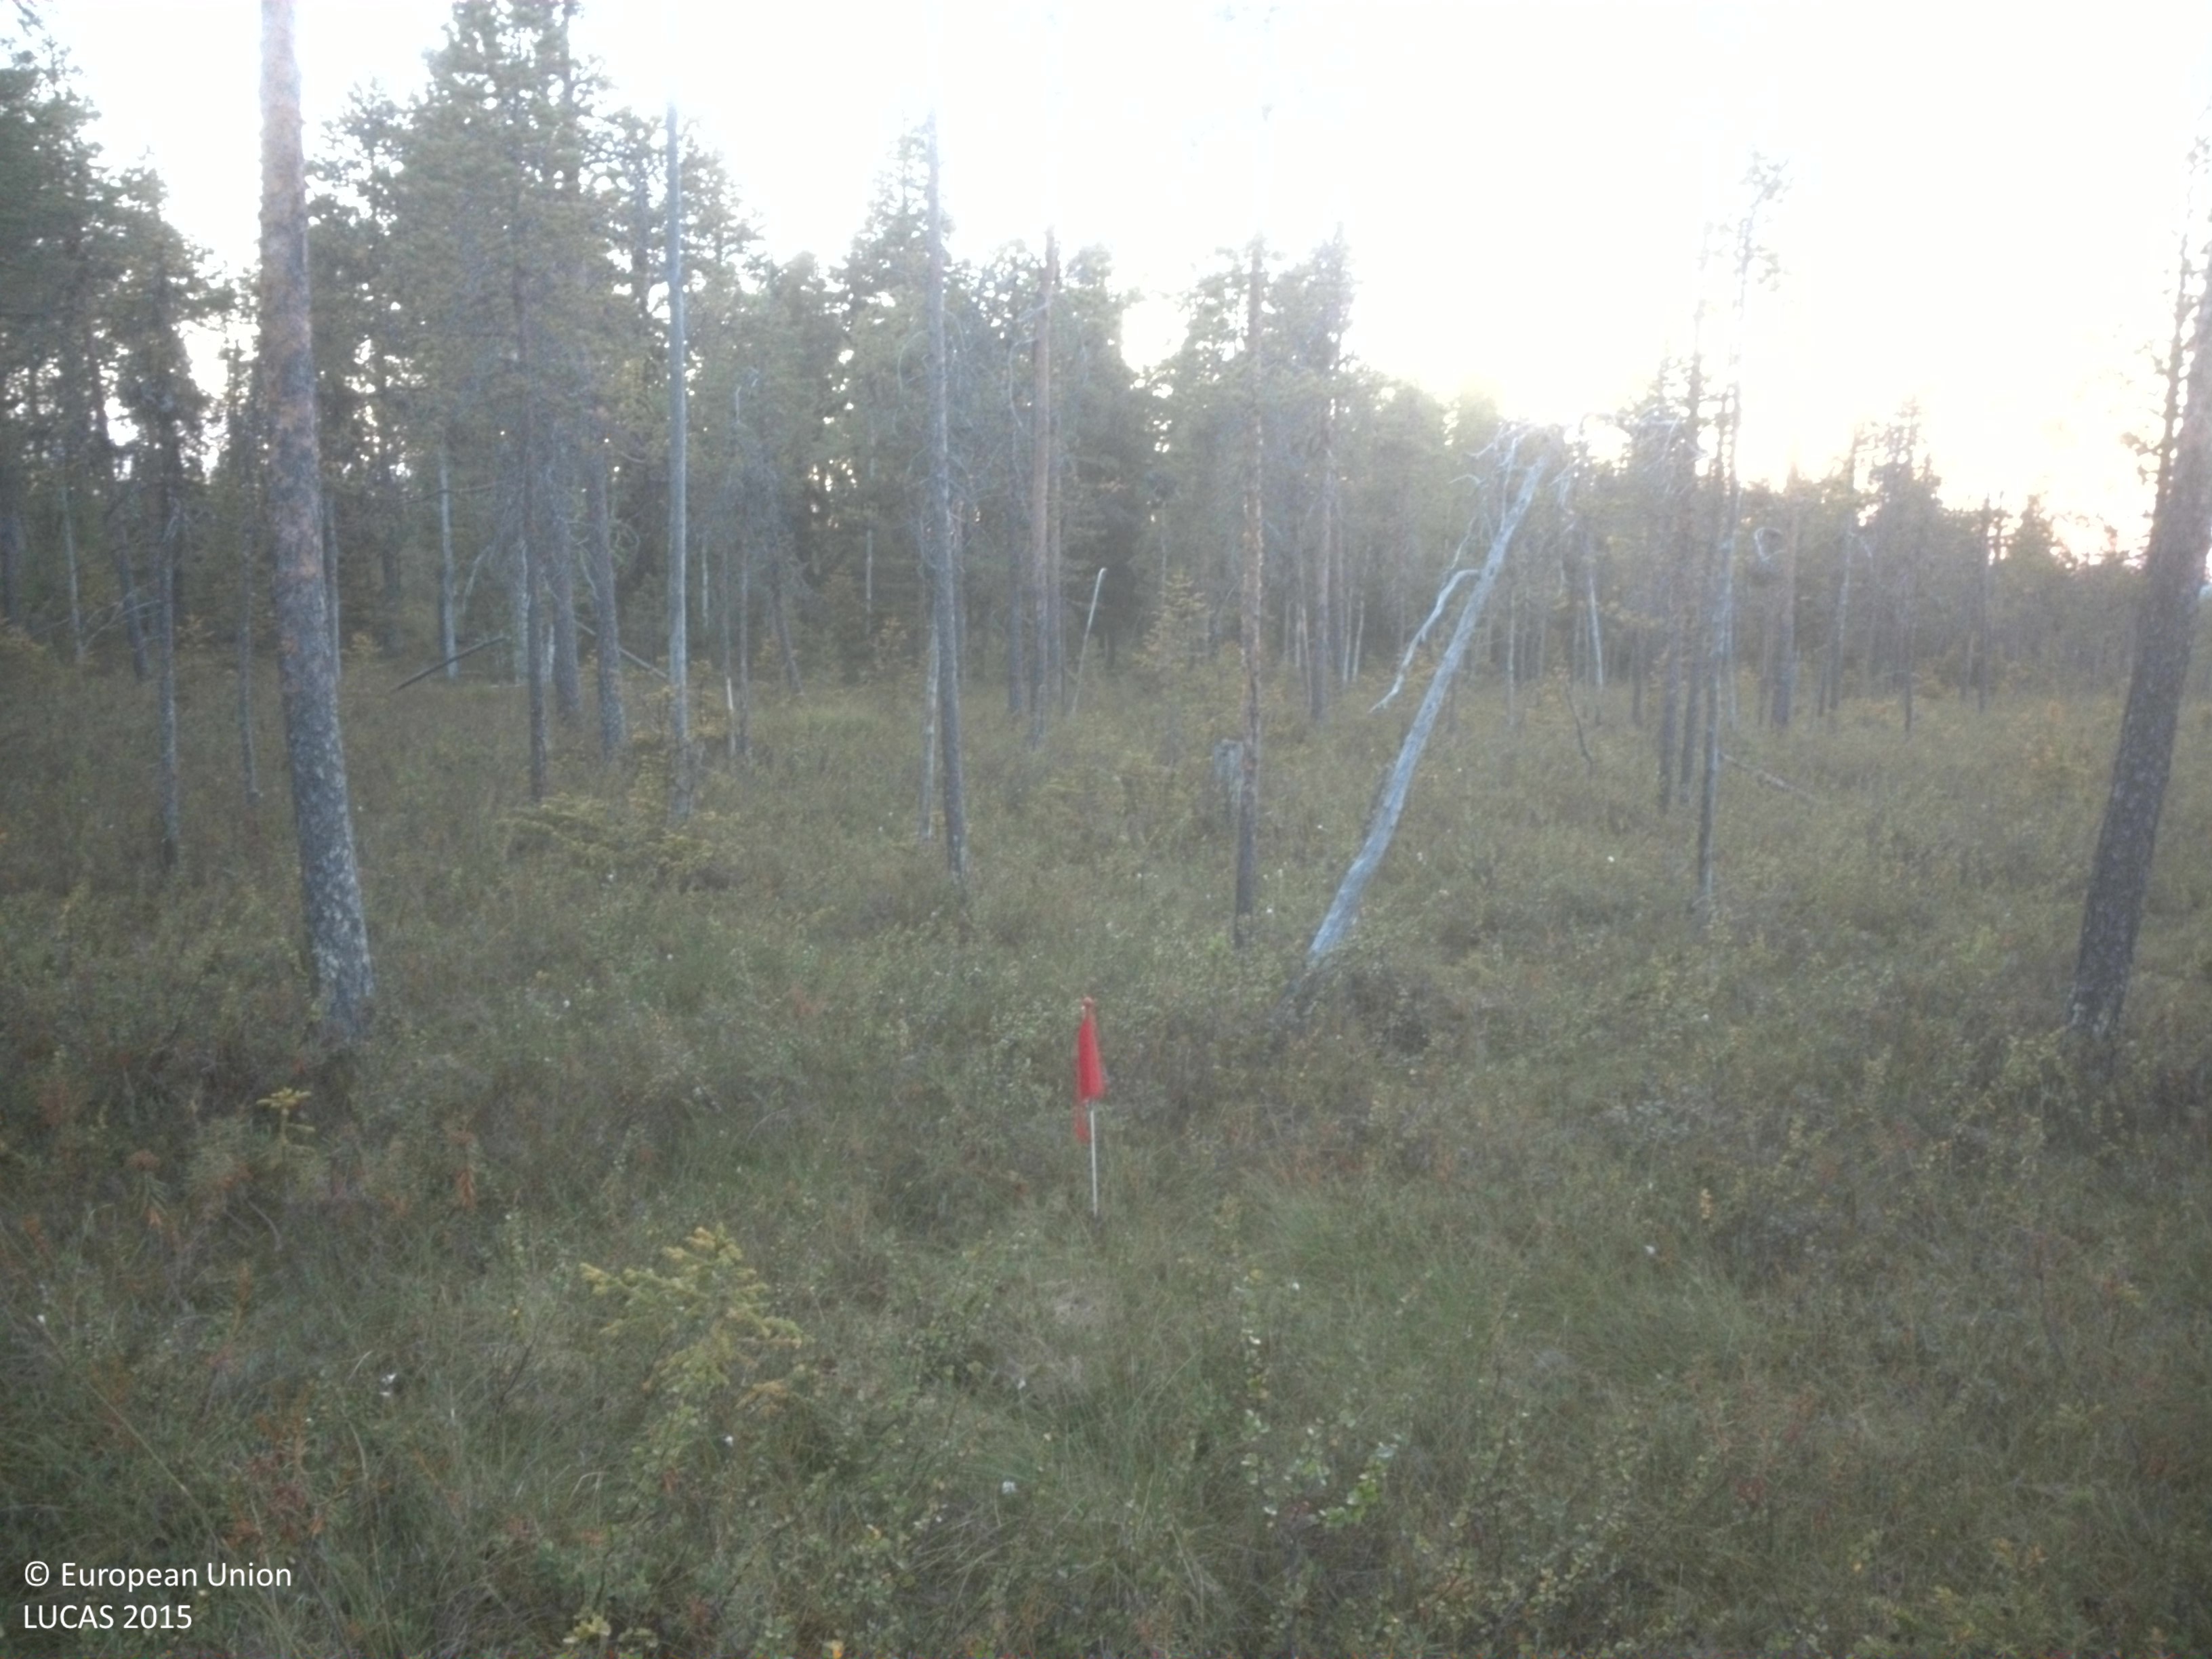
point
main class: Woodland
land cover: Pine dominated coniferous woodland
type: boreal forest
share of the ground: 10 - 25 %
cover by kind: shrubs 30 %, herbaceous plants 30 %, coniferous forest trees 20 %, lichens and mosses 20 %
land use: Forestry
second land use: Other primary production
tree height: > 5 m
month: August
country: SE
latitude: 64.6258
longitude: 18.8150
